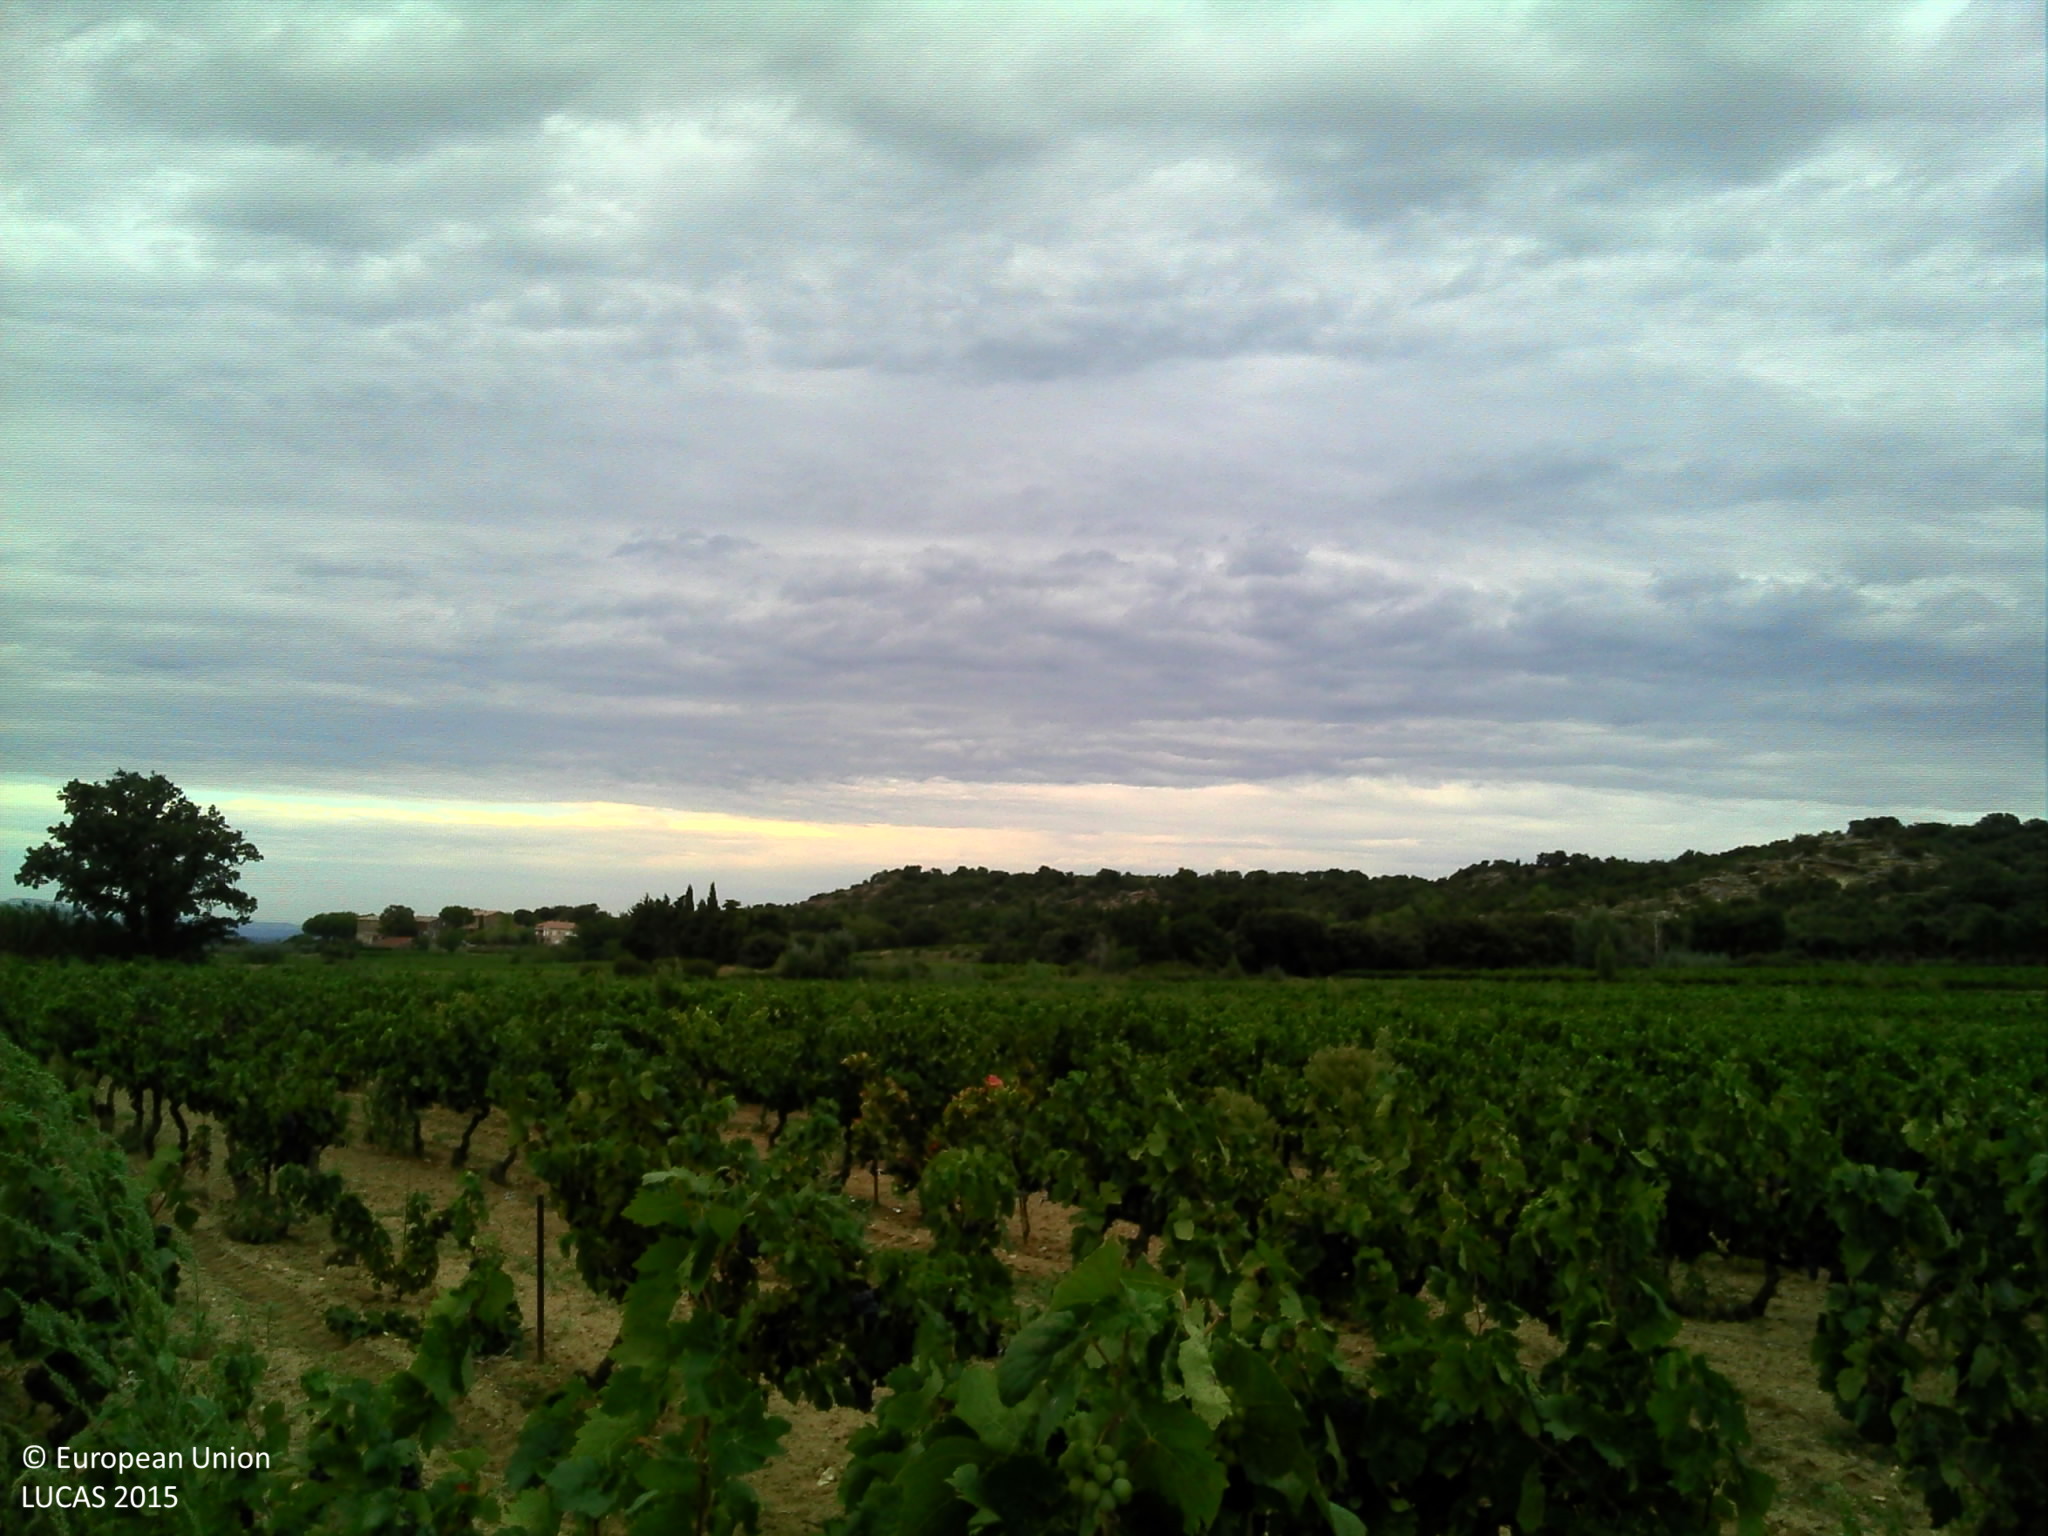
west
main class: Cropland
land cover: Vineyards
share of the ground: 50 - 75 %
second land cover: Other bare soil
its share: > 75 %
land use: Agriculture (excluding fallow land and kitchen gardens)
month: September
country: FR
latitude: 44.4118
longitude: 5.0217
